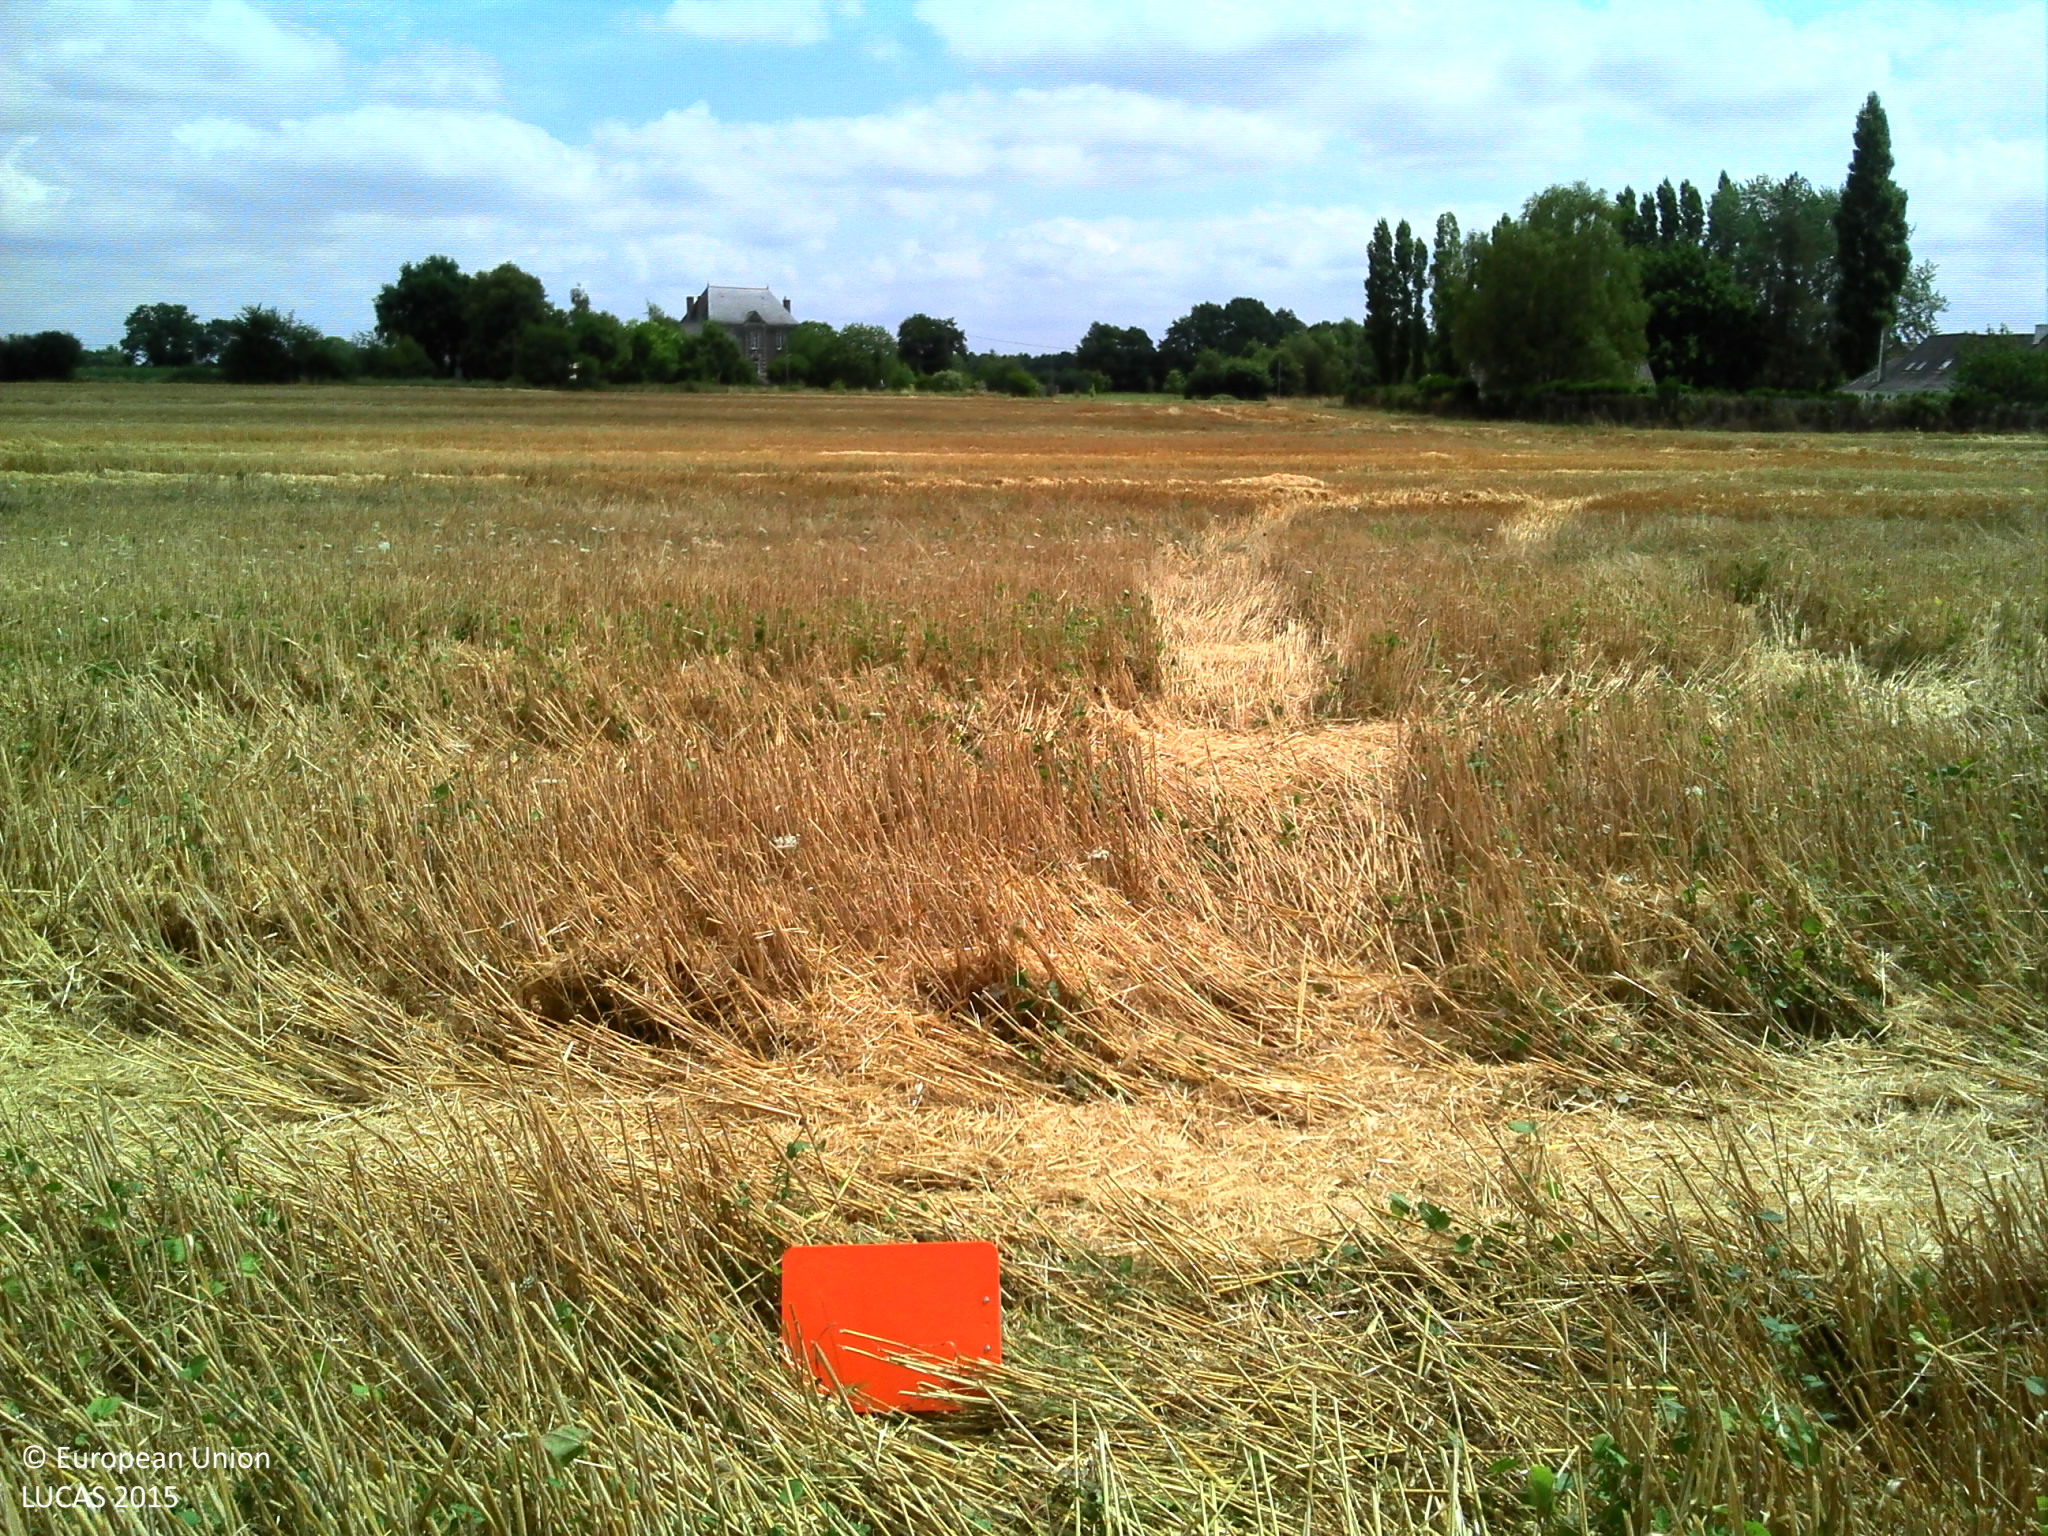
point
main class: Cropland
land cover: Rye
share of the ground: > 75 %
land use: Agriculture (excluding fallow land and kitchen gardens)
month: August
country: FR
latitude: 47.7632
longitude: -1.3426
